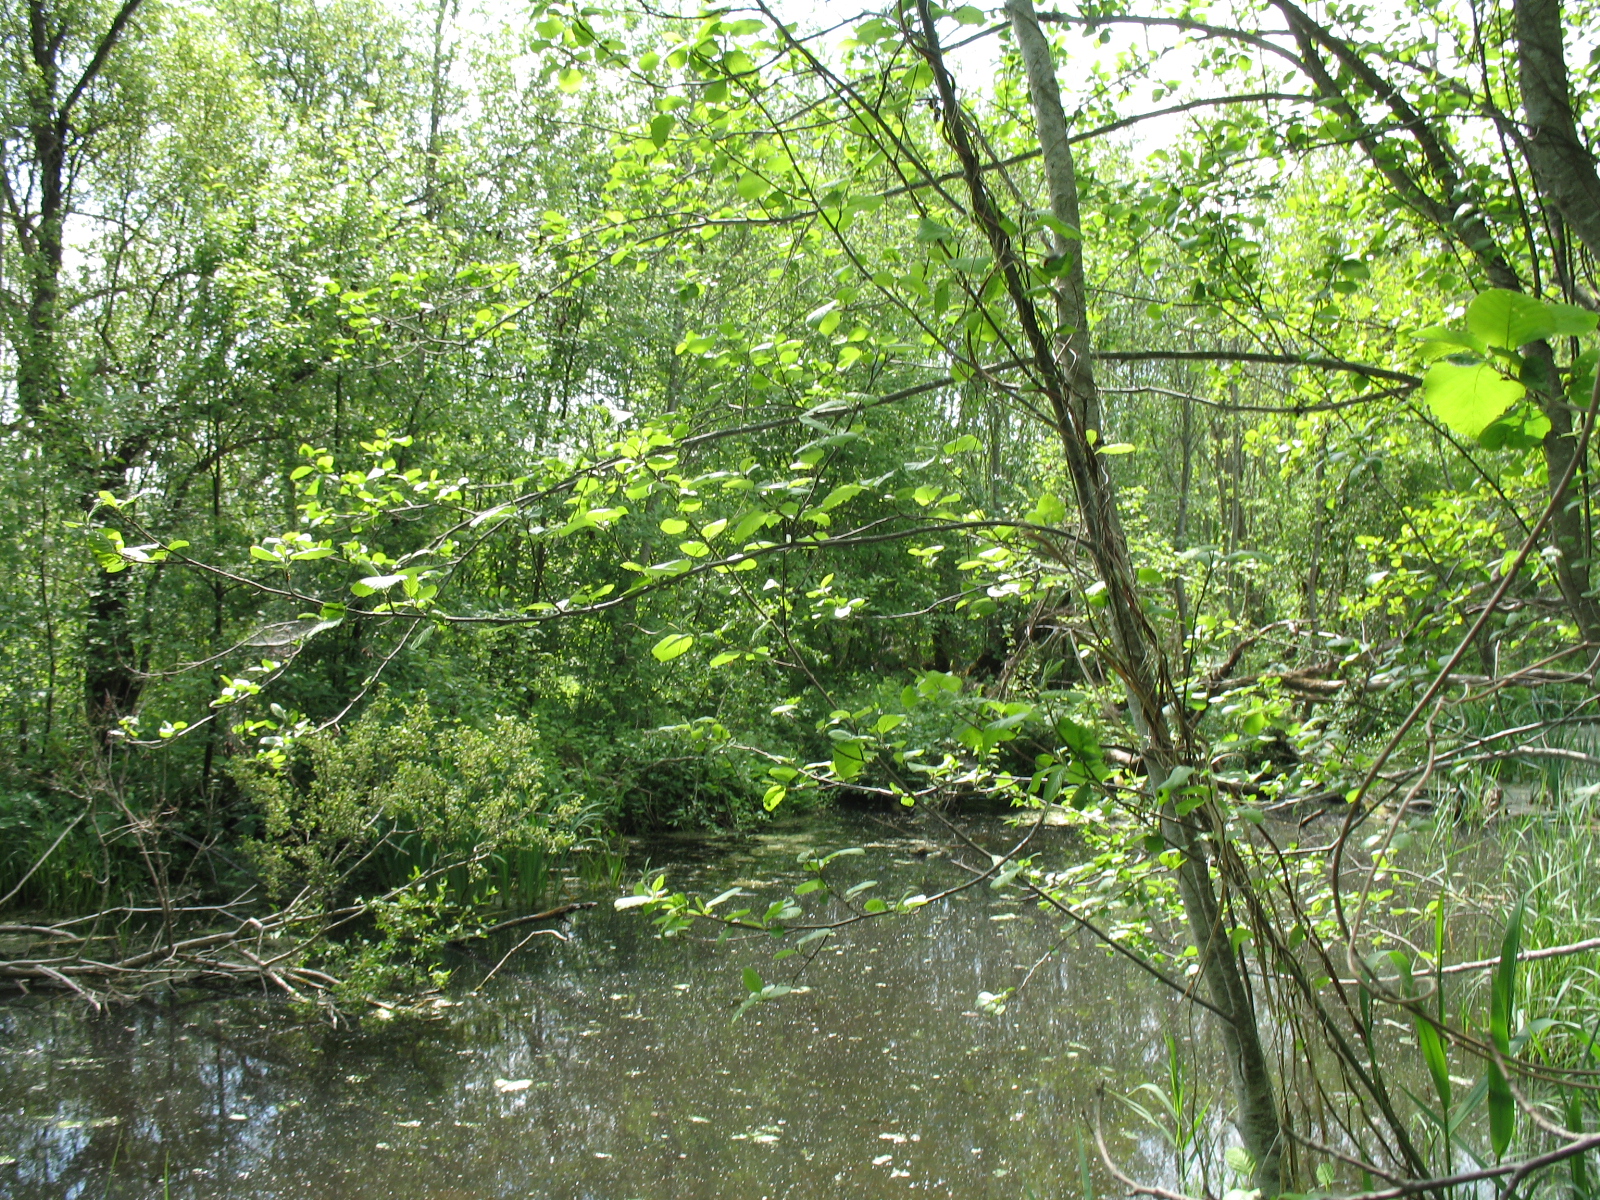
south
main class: Woodland
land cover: Broadleaved woodland
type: floodplain forest
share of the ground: > 75 %
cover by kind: broadleaved forest trees 95 %, herbaceous plants 5 %
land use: Forestry
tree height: > 5 m
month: May
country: LV
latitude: 56.8331
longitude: 23.5633
